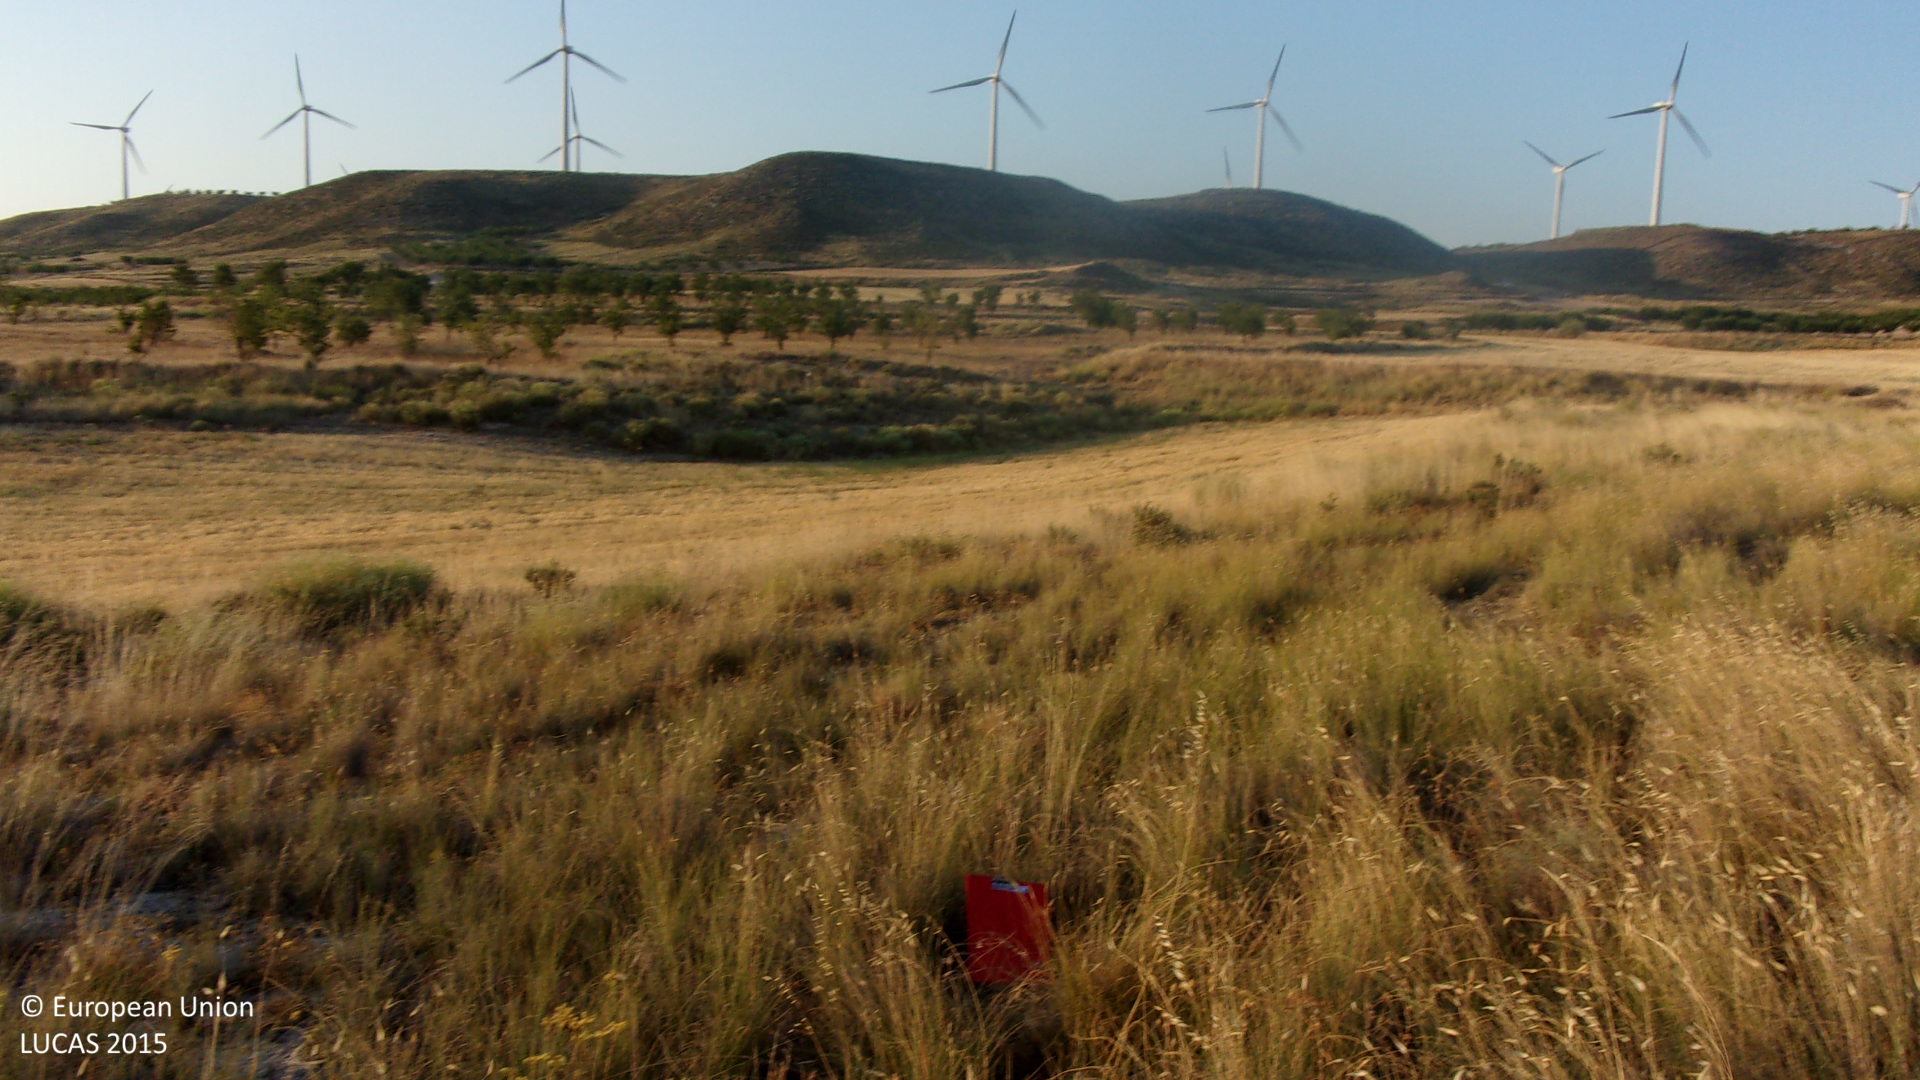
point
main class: Shrubland
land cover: Shrubland without tree cover
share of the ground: > 75 %
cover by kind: shrubs 75 %, herbaceous plants 15 %, consolidated bare surface 10 %
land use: Semi-natural and natural areas not in use
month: July
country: ES
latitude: 41.7993
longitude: -1.4734
